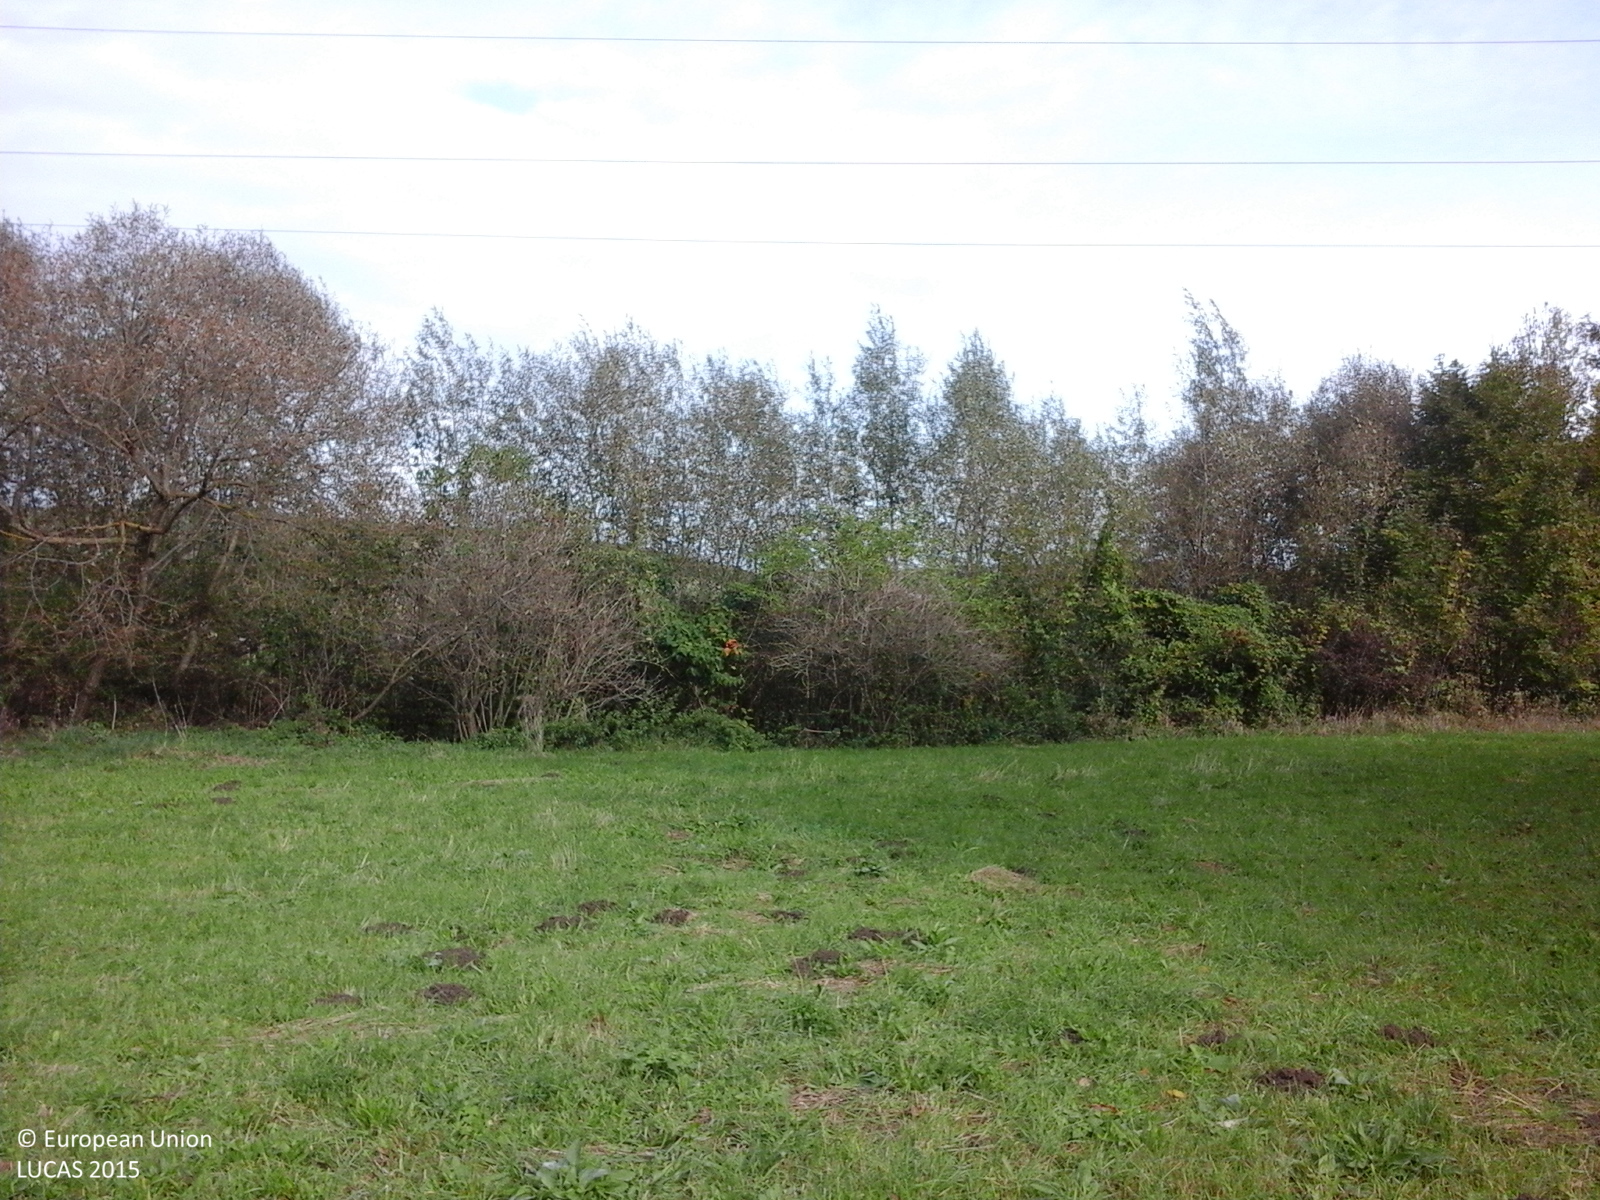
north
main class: Grassland
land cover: Grassland without tree/shrub cover
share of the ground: > 75 %
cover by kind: herbaceous plants 100 %
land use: Agriculture (excluding fallow land and kitchen gardens)
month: October
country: RO
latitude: 46.3574
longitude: 25.1893
